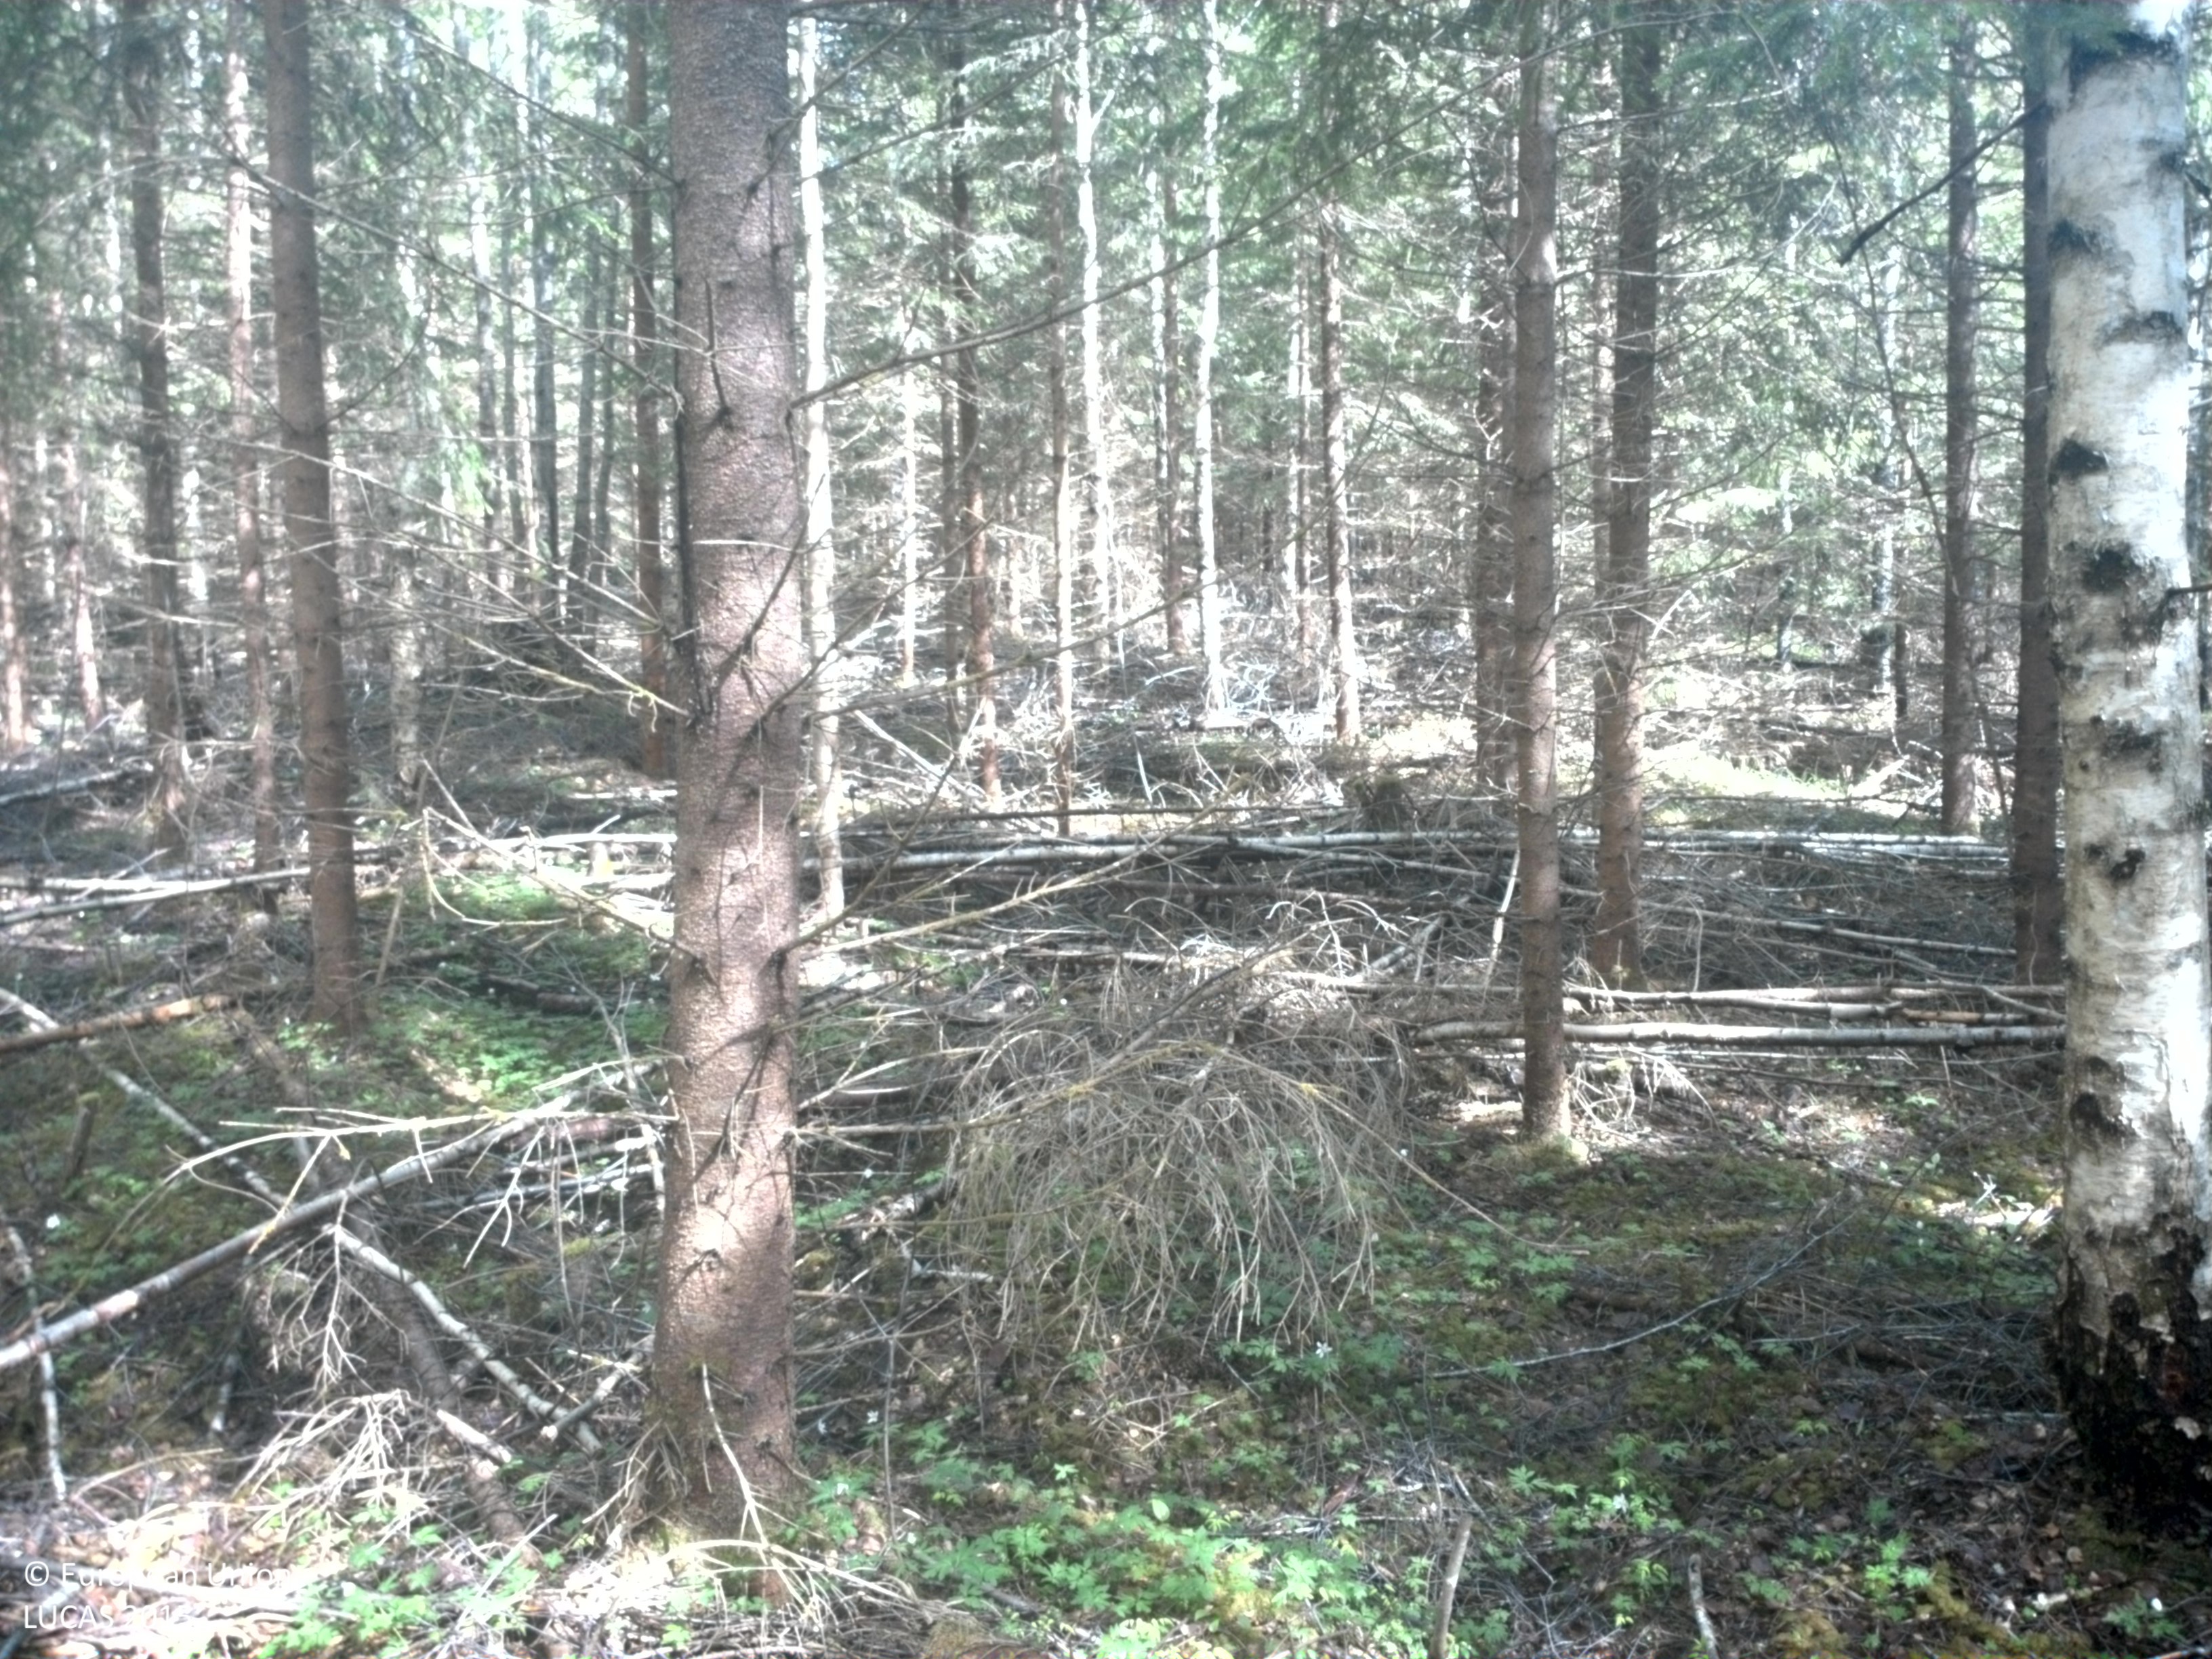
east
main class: Woodland
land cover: Broadleaved woodland
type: boreal forest
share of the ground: > 75 %
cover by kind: broadleaved forest trees 95 %, coniferous forest trees 5 %
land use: Forestry
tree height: > 5 m
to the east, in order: Broadleaved woodland; Spruce dominated mixed woodland; Spruce dominated coniferous woodland; Broadleaved woodland; Rivers and streams; Spruce dominated mixed woodland; Broadleaved woodland; Grassland without tree/shrub cover; Artificial constructions in urban areas; Electric lines; Artificial constructions in urban areas; Spruce dominated coniferous woodland
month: May
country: SE
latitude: 59.5297
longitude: 12.4159
